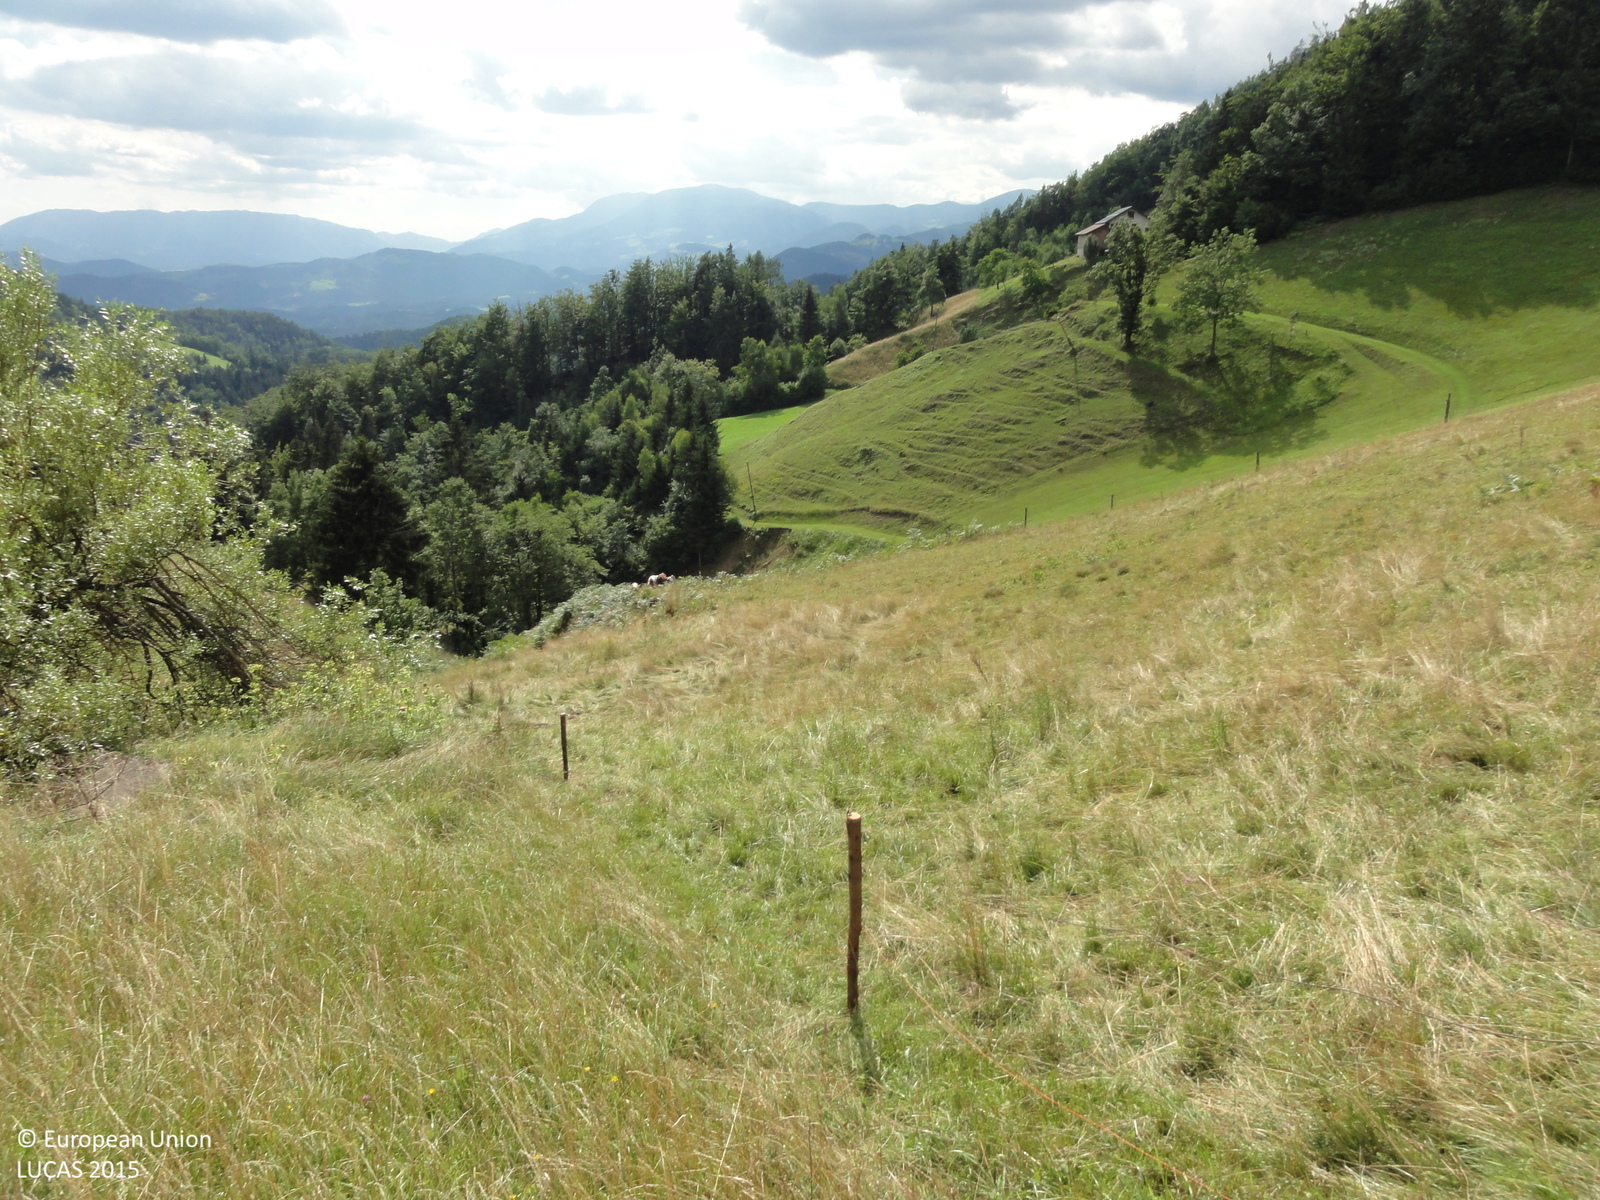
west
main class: Grassland
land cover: Grassland without tree/shrub cover
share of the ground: > 75 %
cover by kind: herbaceous plants 100 %
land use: Agriculture (excluding fallow land and kitchen gardens)
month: July
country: SI
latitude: 46.4275
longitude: 15.1120
